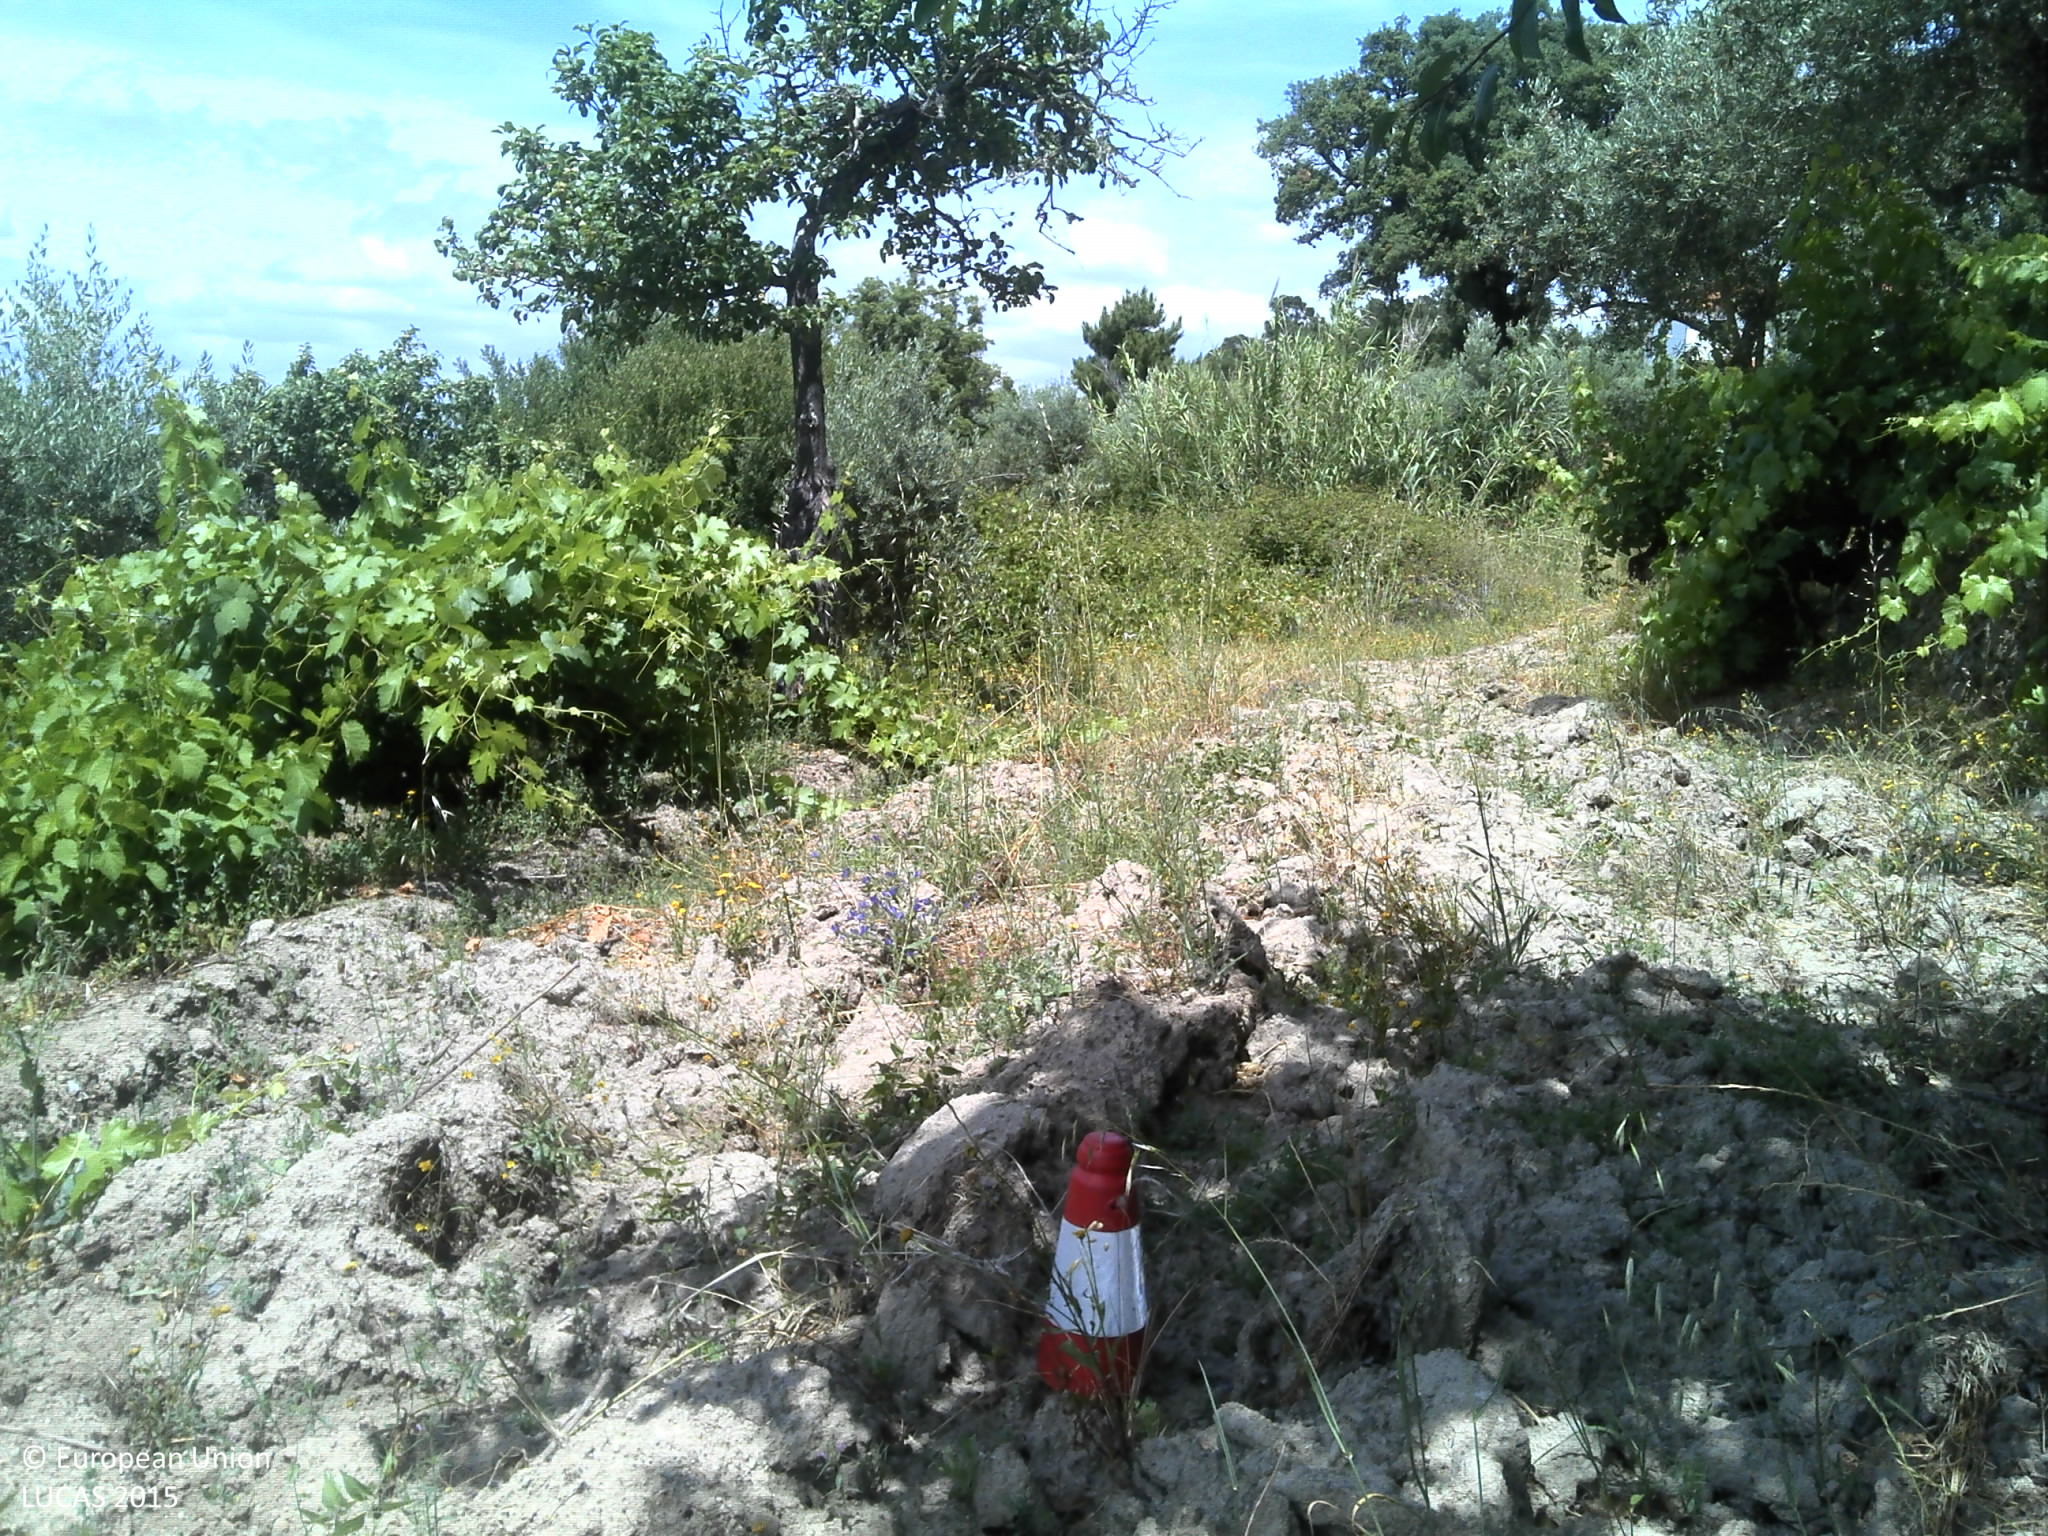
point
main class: Cropland
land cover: Olive groves
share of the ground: 25 - 50 %
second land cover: Other bare soil
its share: > 75 %
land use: Agriculture (excluding fallow land and kitchen gardens)
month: June
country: PT
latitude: 40.1534
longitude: -7.4189
